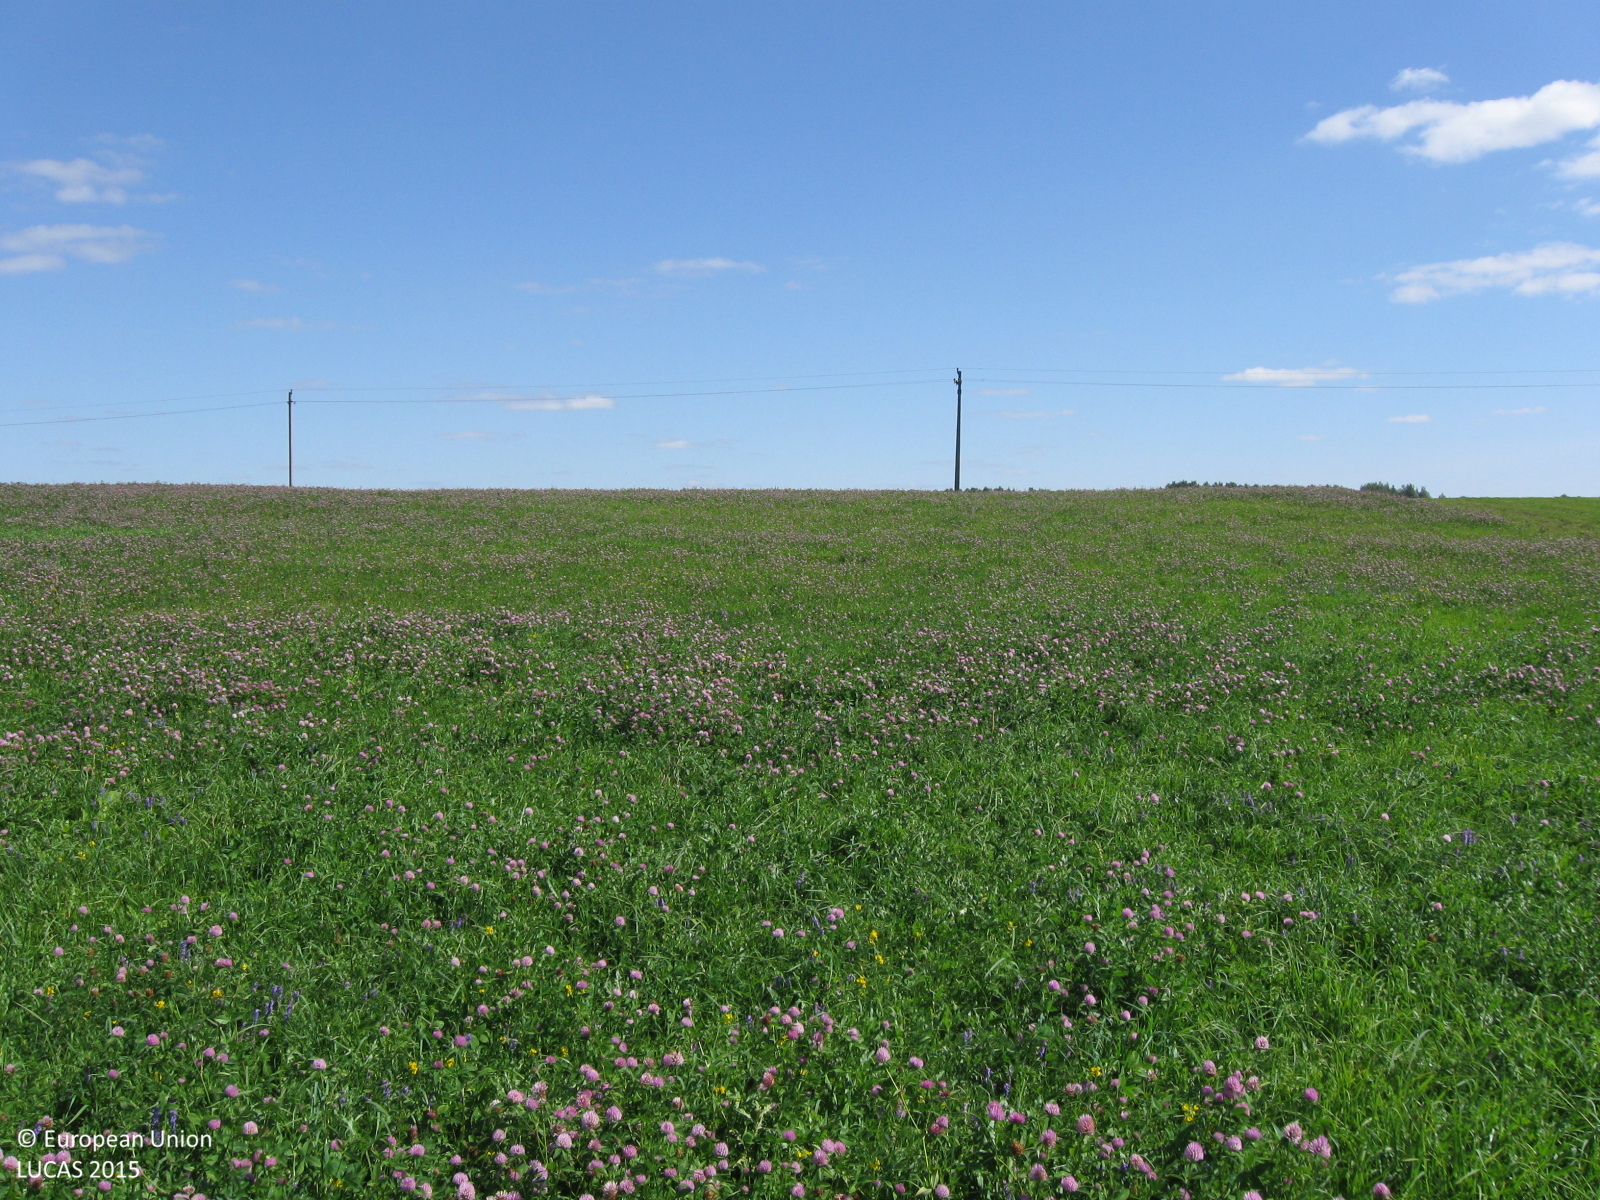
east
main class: Cropland
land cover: Other leguminous and mixtures for fodder
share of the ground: > 75 %
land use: Agriculture (excluding fallow land and kitchen gardens)
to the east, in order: Other leguminous and mixtures for fodder; Electric lines; Other leguminous and mixtures for fodder; Spontaneously vegetated surfaces; Paved roads, cycling and walking lanes; Spontaneously vegetated surfaces; Common wheat
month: August
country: LT
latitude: 55.5454
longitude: 22.5990
